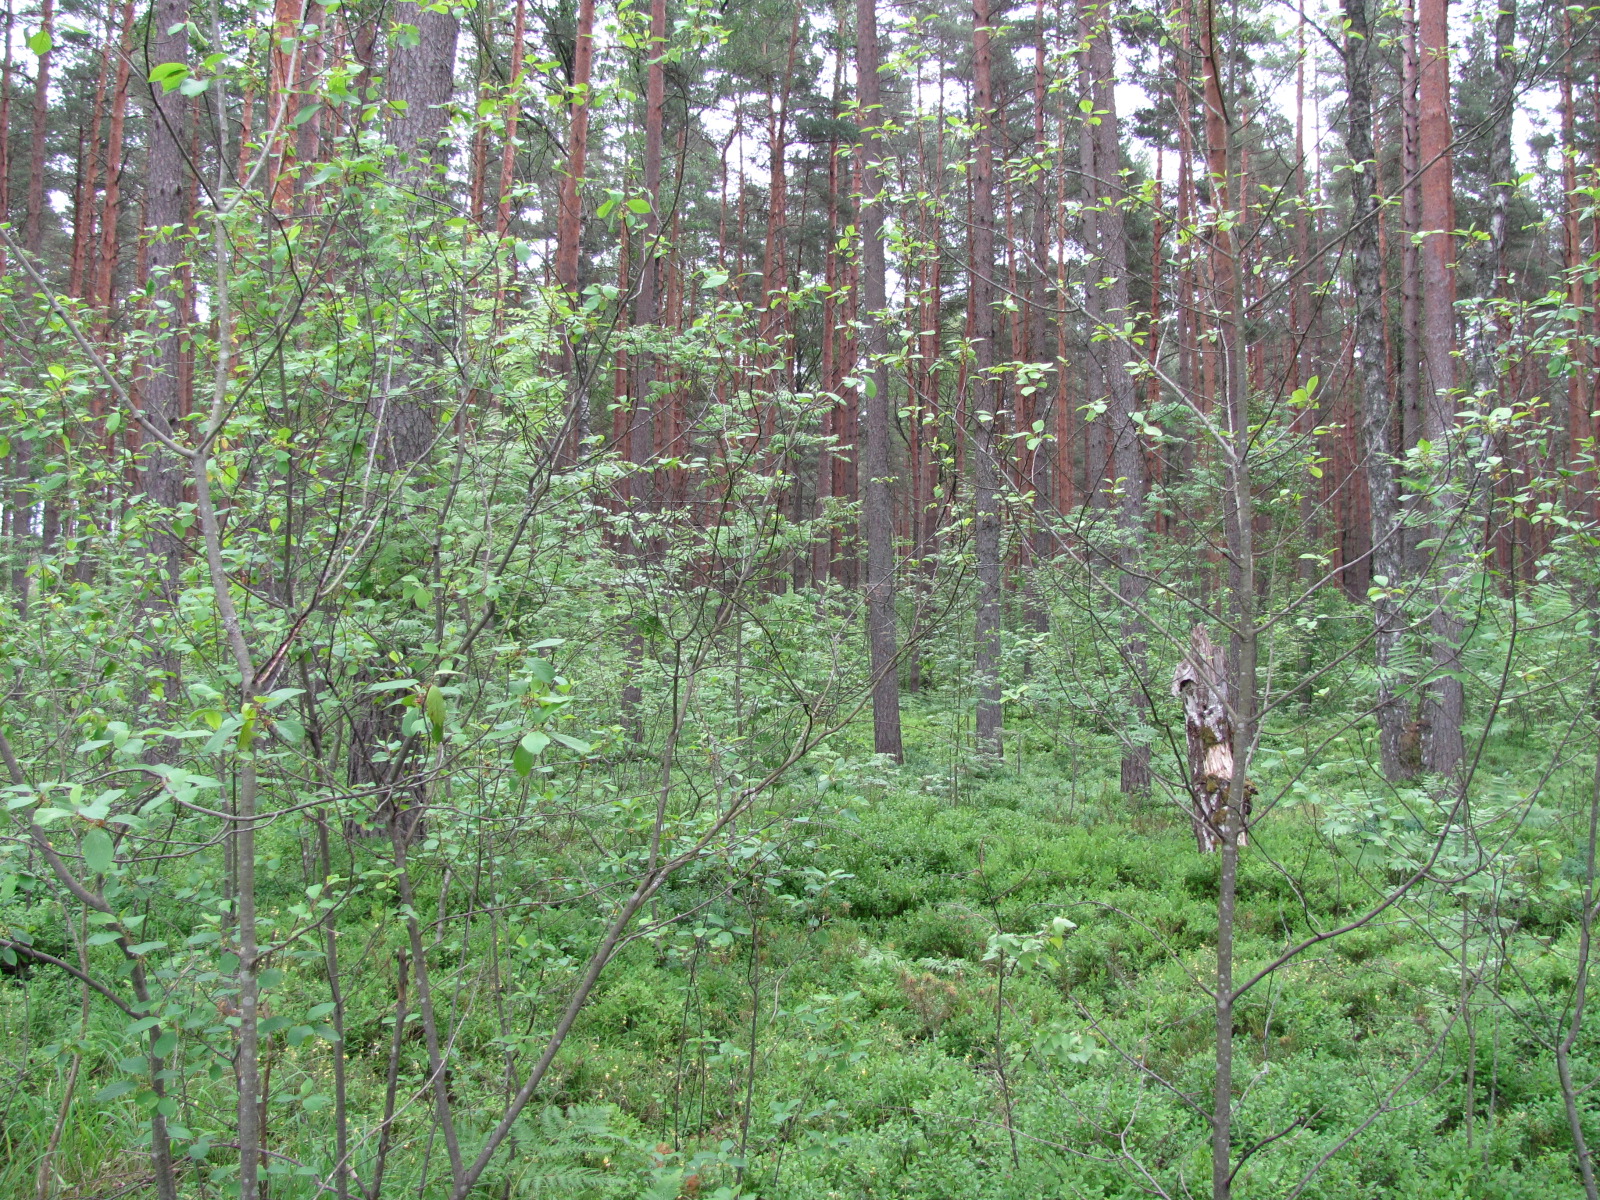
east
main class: Woodland
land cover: Pine dominated mixed woodland
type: hemiboreal forest and nemoral coniferous forest and mixed broadleaved-coniferous forest
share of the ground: > 75 %
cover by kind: coniferous forest trees 60 %, broadleaved forest trees 25 %, herbaceous plants 15 %
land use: Forestry
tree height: > 5 m
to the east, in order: Pine dominated mixed woodland; Ditches and canals; Pine dominated mixed woodland
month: June
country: LV
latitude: 56.9078
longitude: 23.8920
